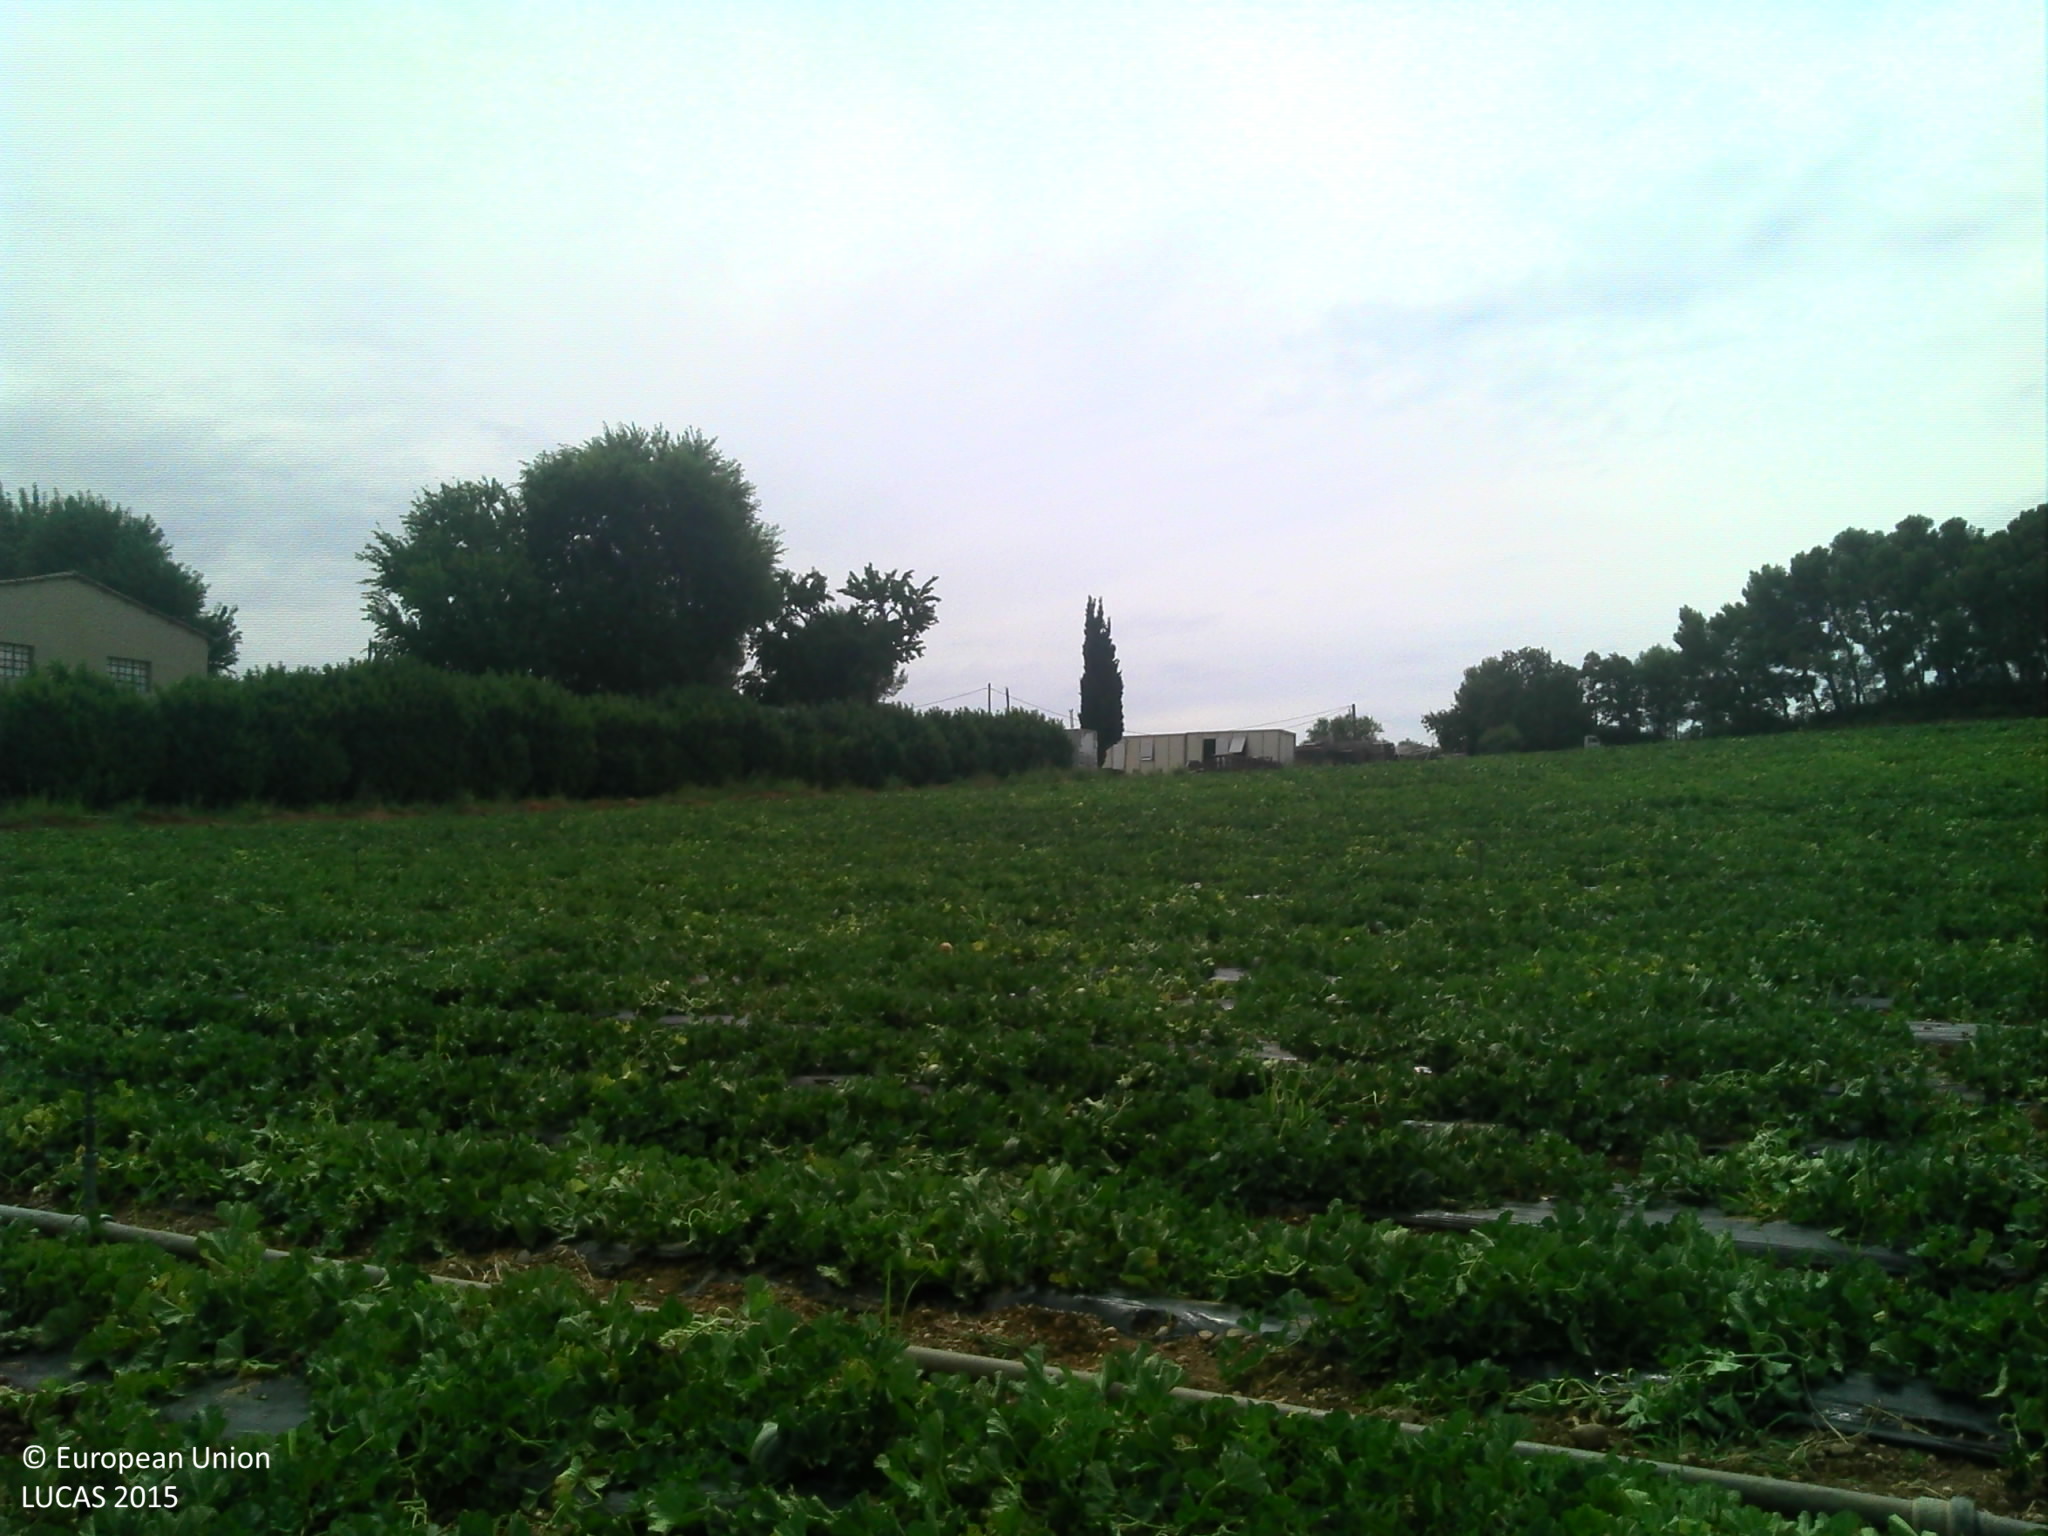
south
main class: Cropland
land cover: Other fresh vegetables
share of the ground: > 75 %
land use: Agriculture (excluding fallow land and kitchen gardens)
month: August
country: FR
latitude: 43.4896
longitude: 5.3975
